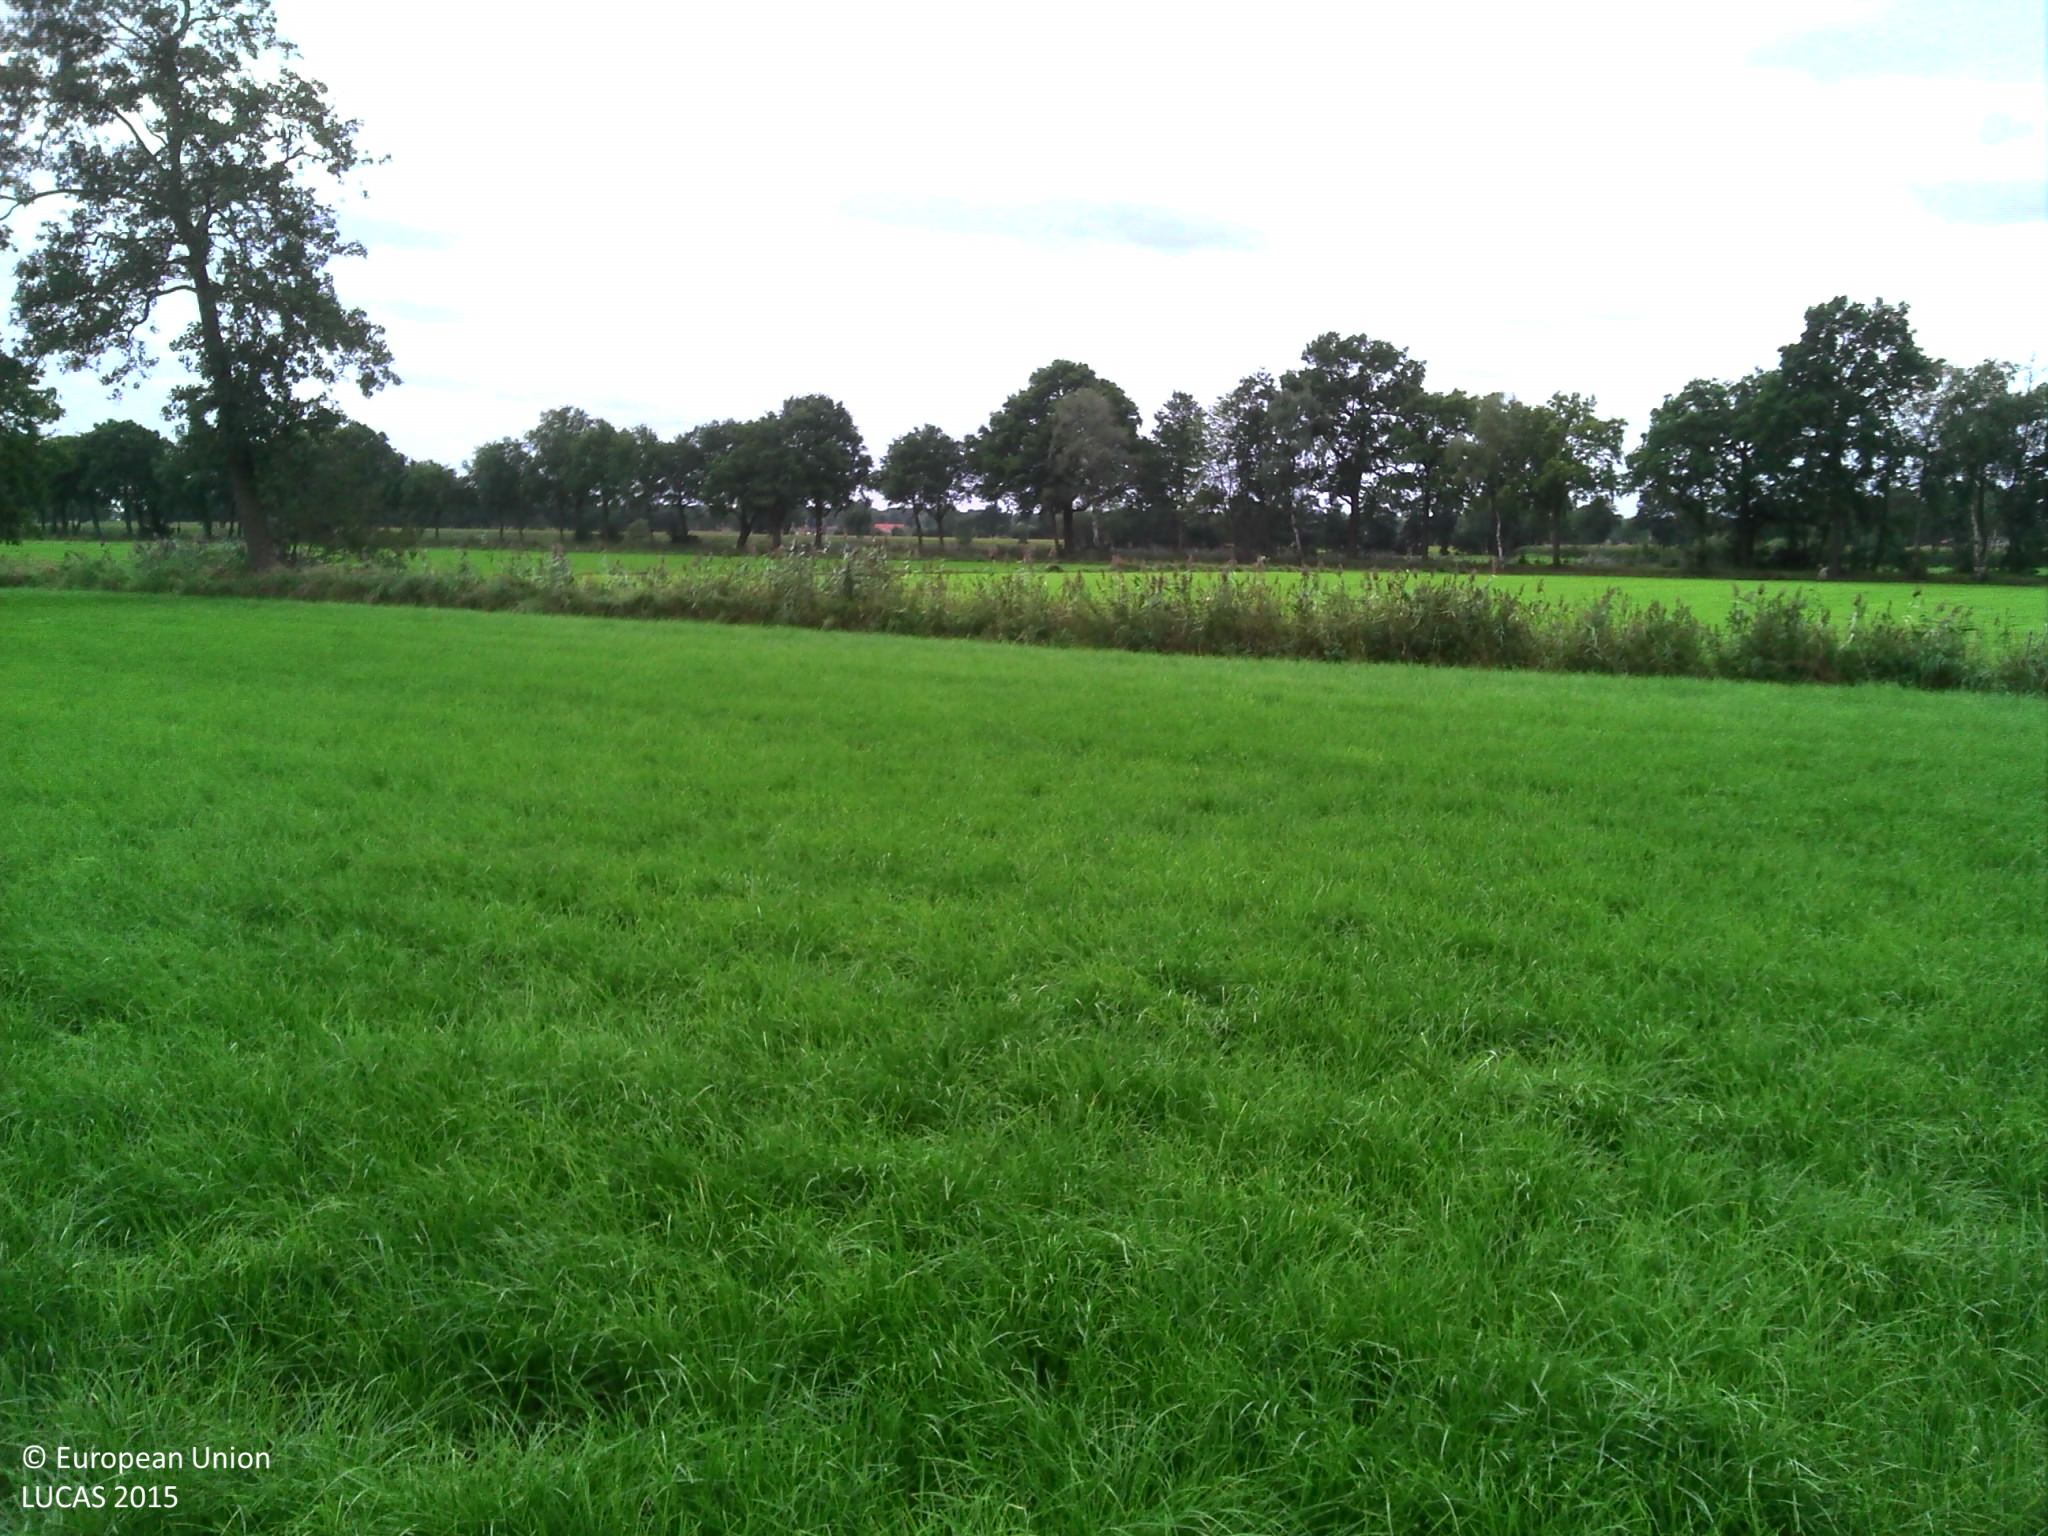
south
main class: Cropland
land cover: Temporary grasslands
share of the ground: > 75 %
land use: Agriculture (excluding fallow land and kitchen gardens)
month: September
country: BE
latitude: 51.3848
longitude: 4.4923
